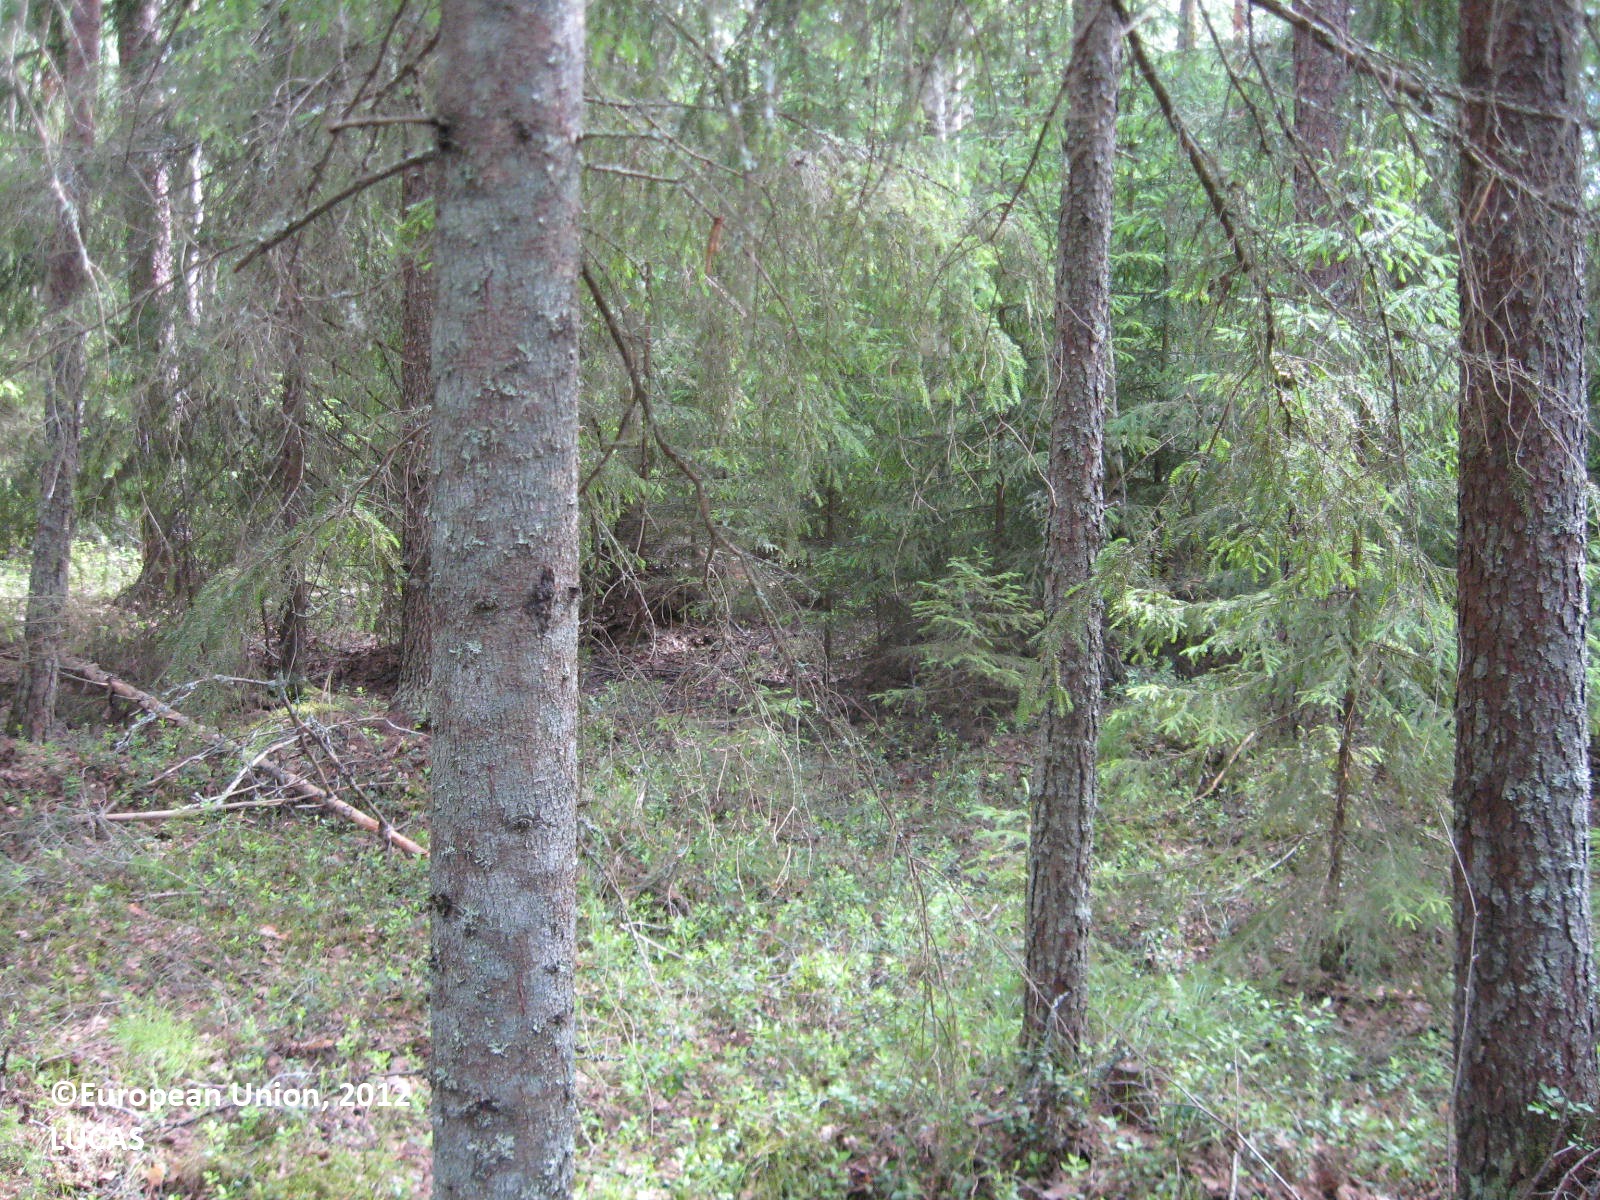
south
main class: Woodland
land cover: Other coniferous woodland
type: boreal forest
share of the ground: > 75 %
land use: Forestry
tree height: > 5 m
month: July
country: FI
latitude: 62.6656
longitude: 22.6078
